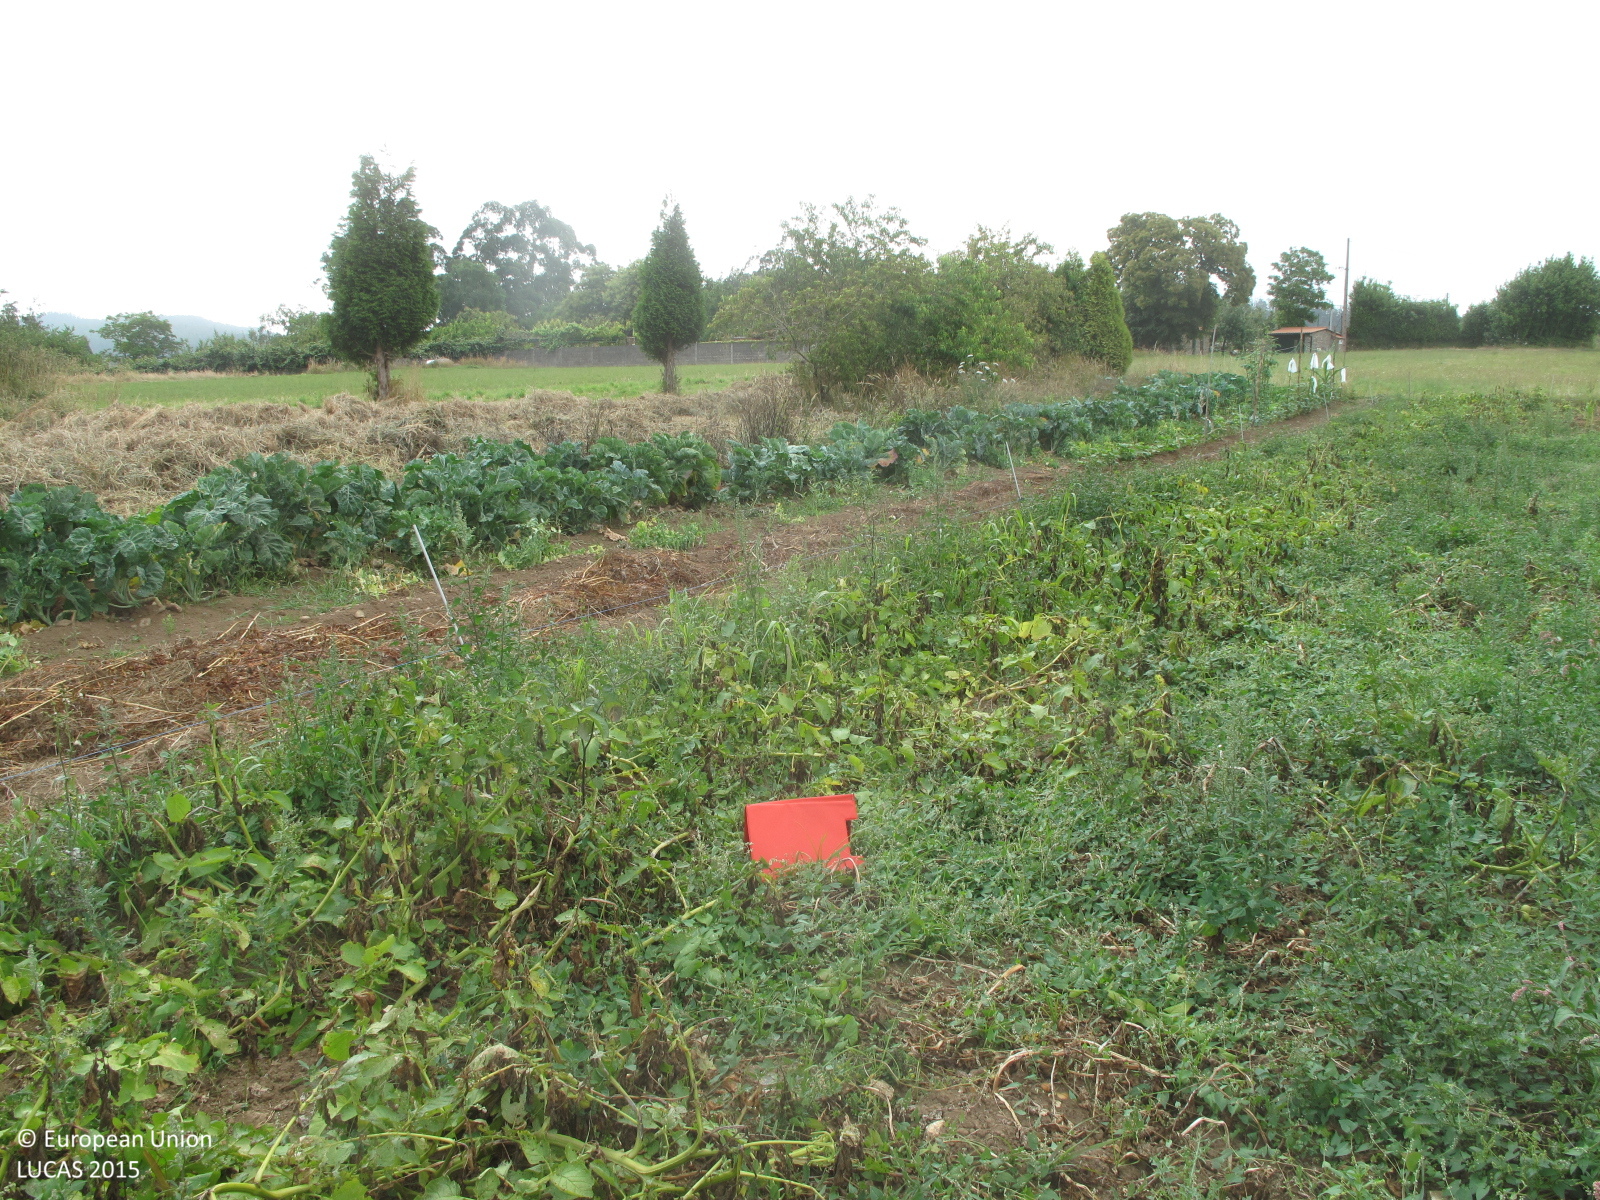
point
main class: Cropland
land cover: Potatoes
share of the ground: 25 - 50 %
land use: Kitchen garden
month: July
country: ES
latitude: 43.5960
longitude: -8.0732
